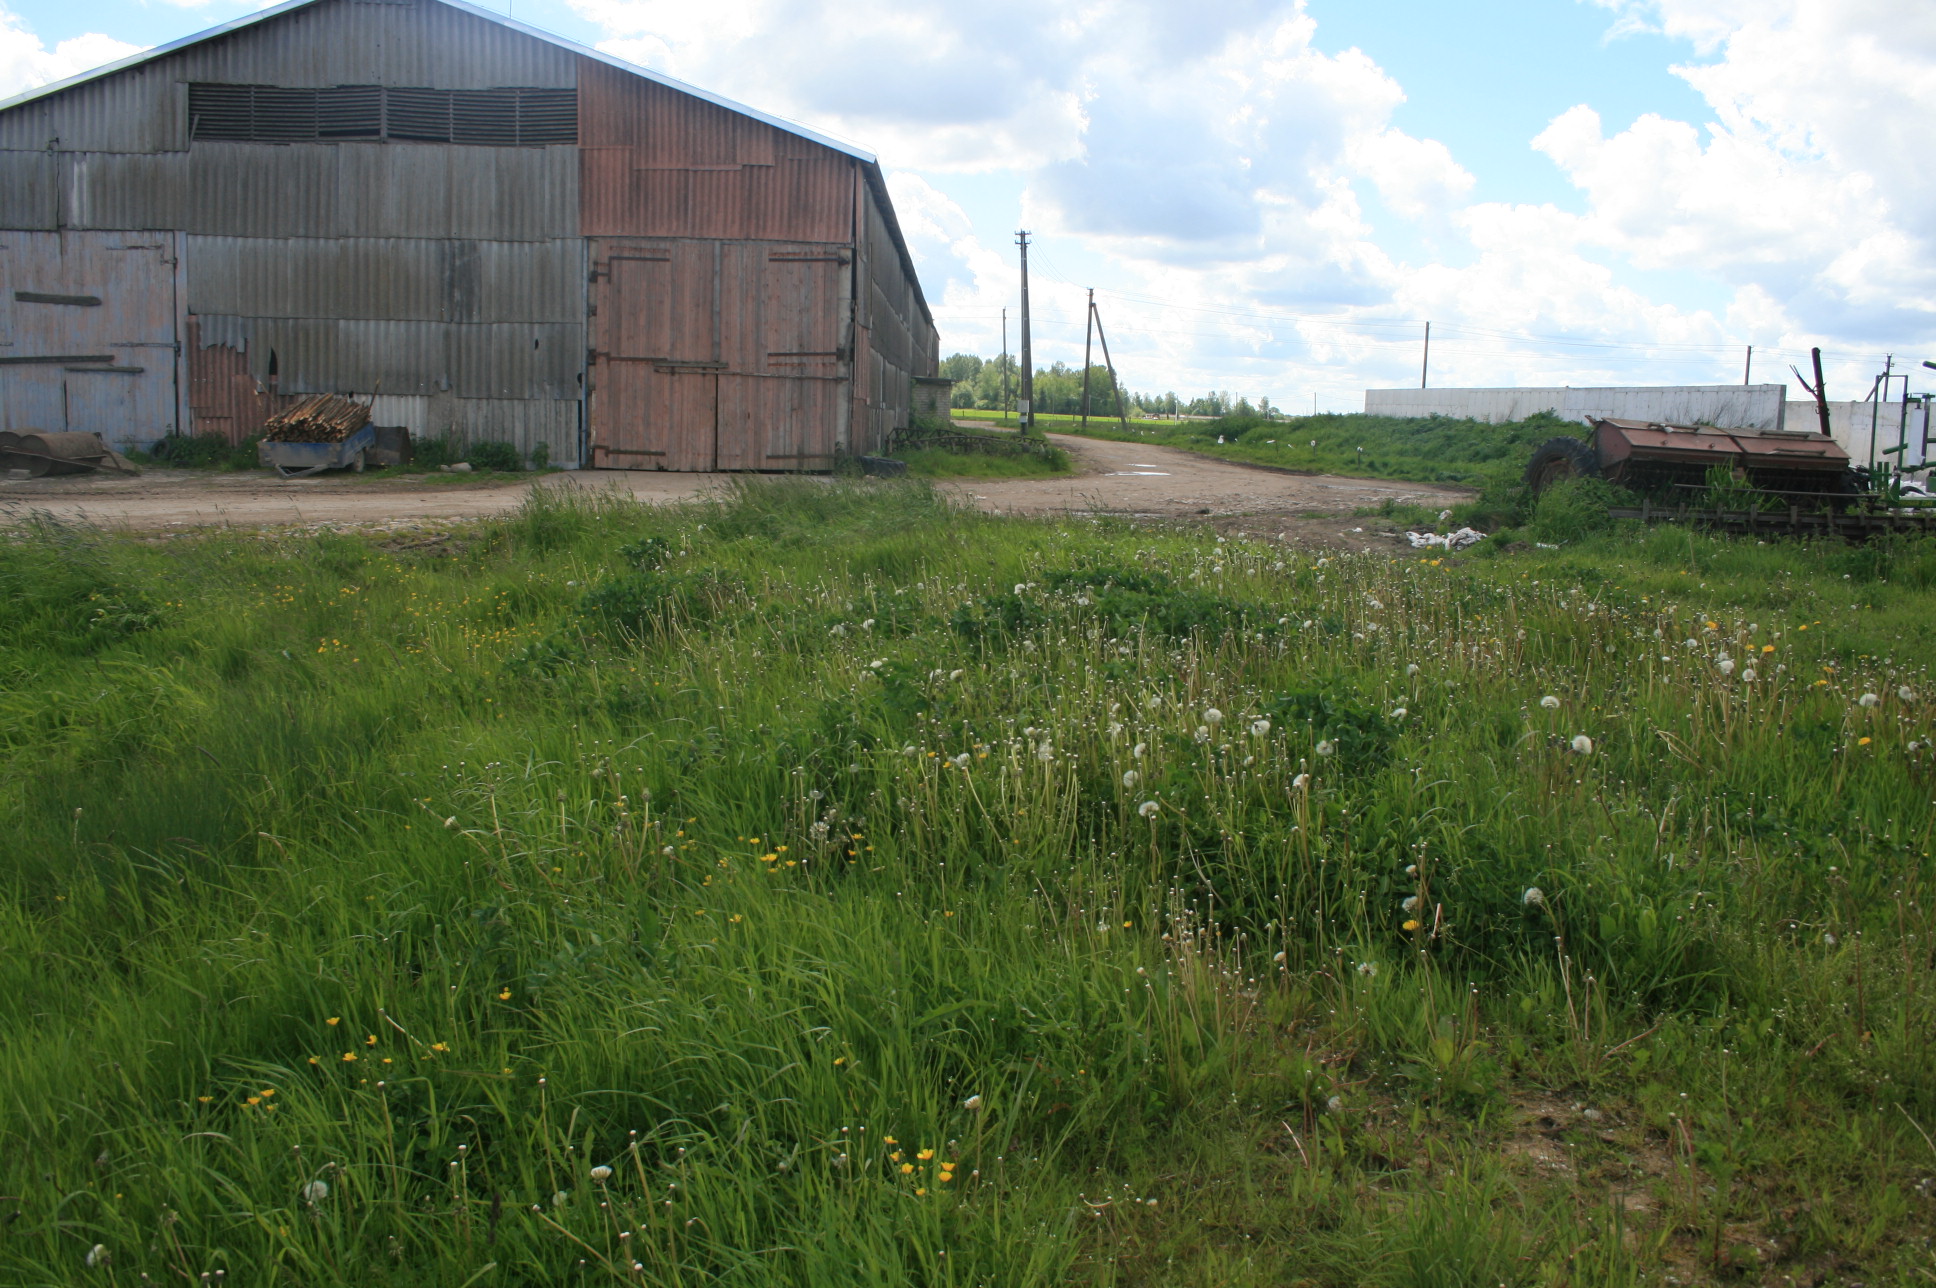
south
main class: Grassland
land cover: Grassland without tree/shrub cover
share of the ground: > 75 %
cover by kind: herbaceous plants 100 %
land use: Agriculture (excluding fallow land and kitchen gardens)
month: May
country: LT
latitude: 55.9919
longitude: 22.3204
